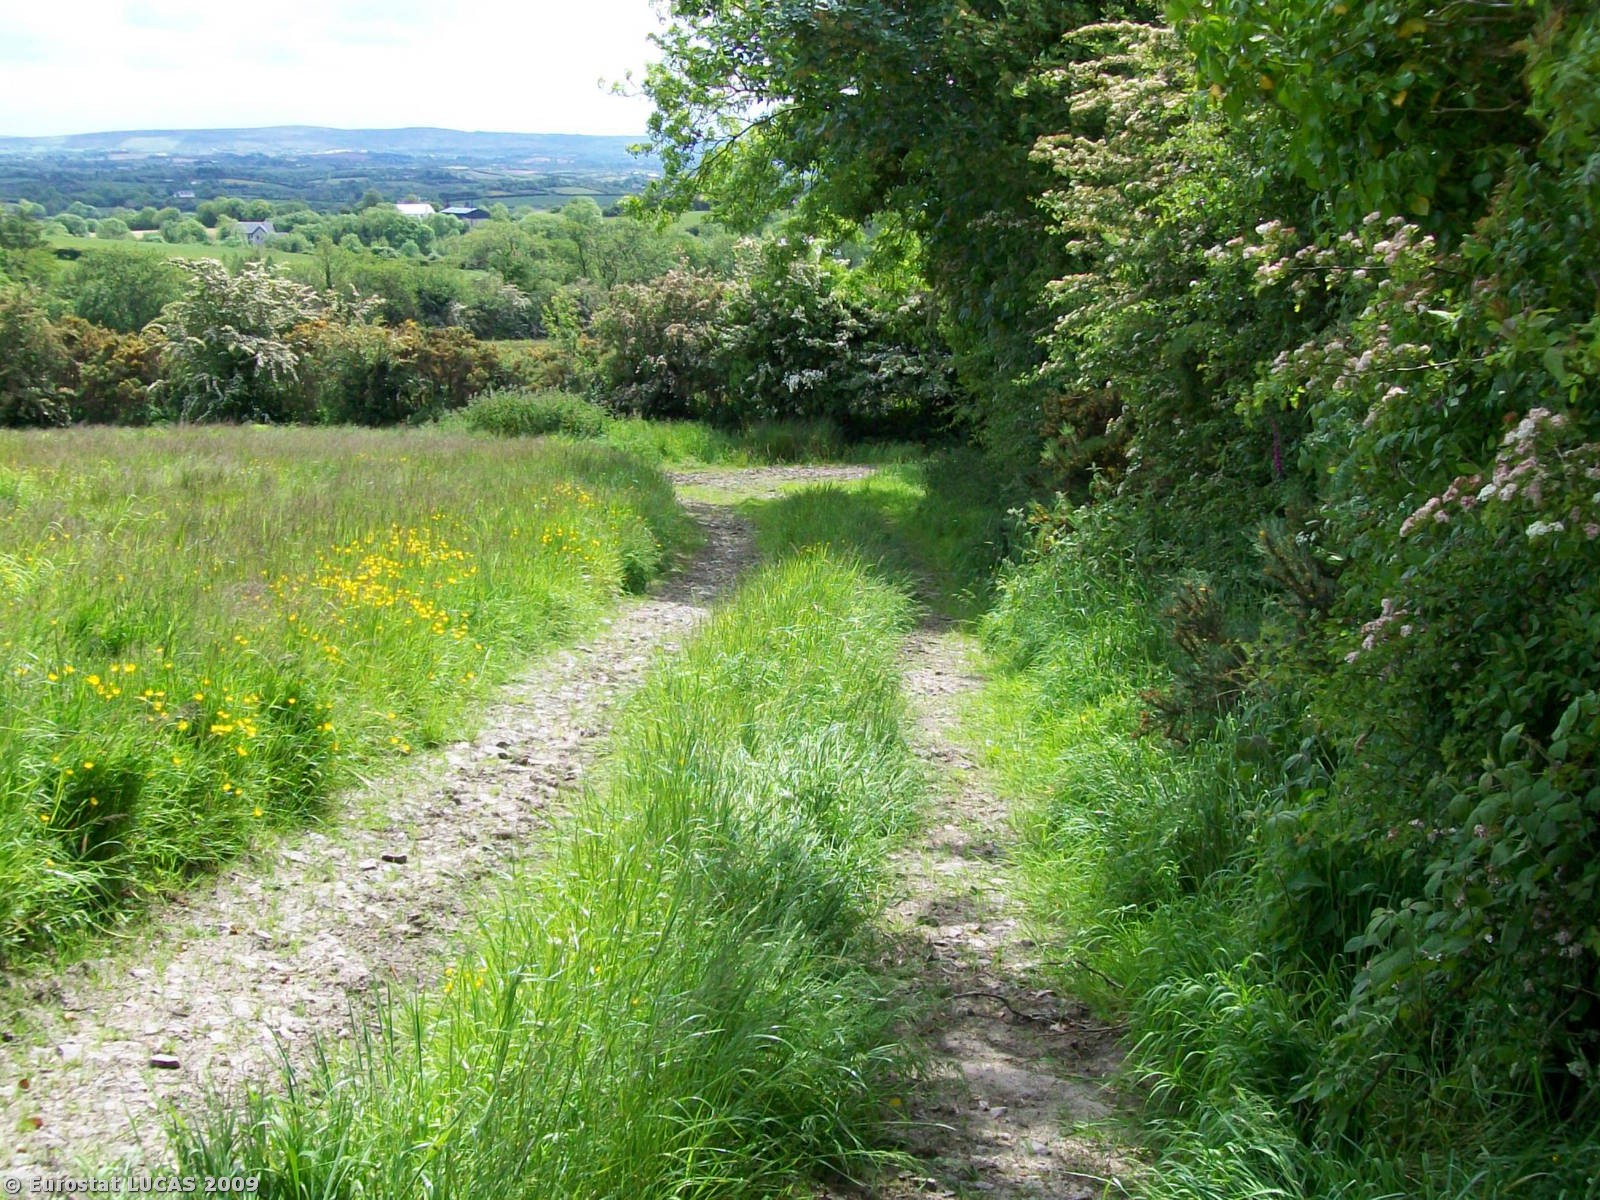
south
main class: Grassland
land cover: Grassland without tree/shrub cover
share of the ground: > 75 %
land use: Agriculture (excluding fallow land and kitchen gardens)
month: June
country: GB
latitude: 54.5568
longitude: -7.4251
